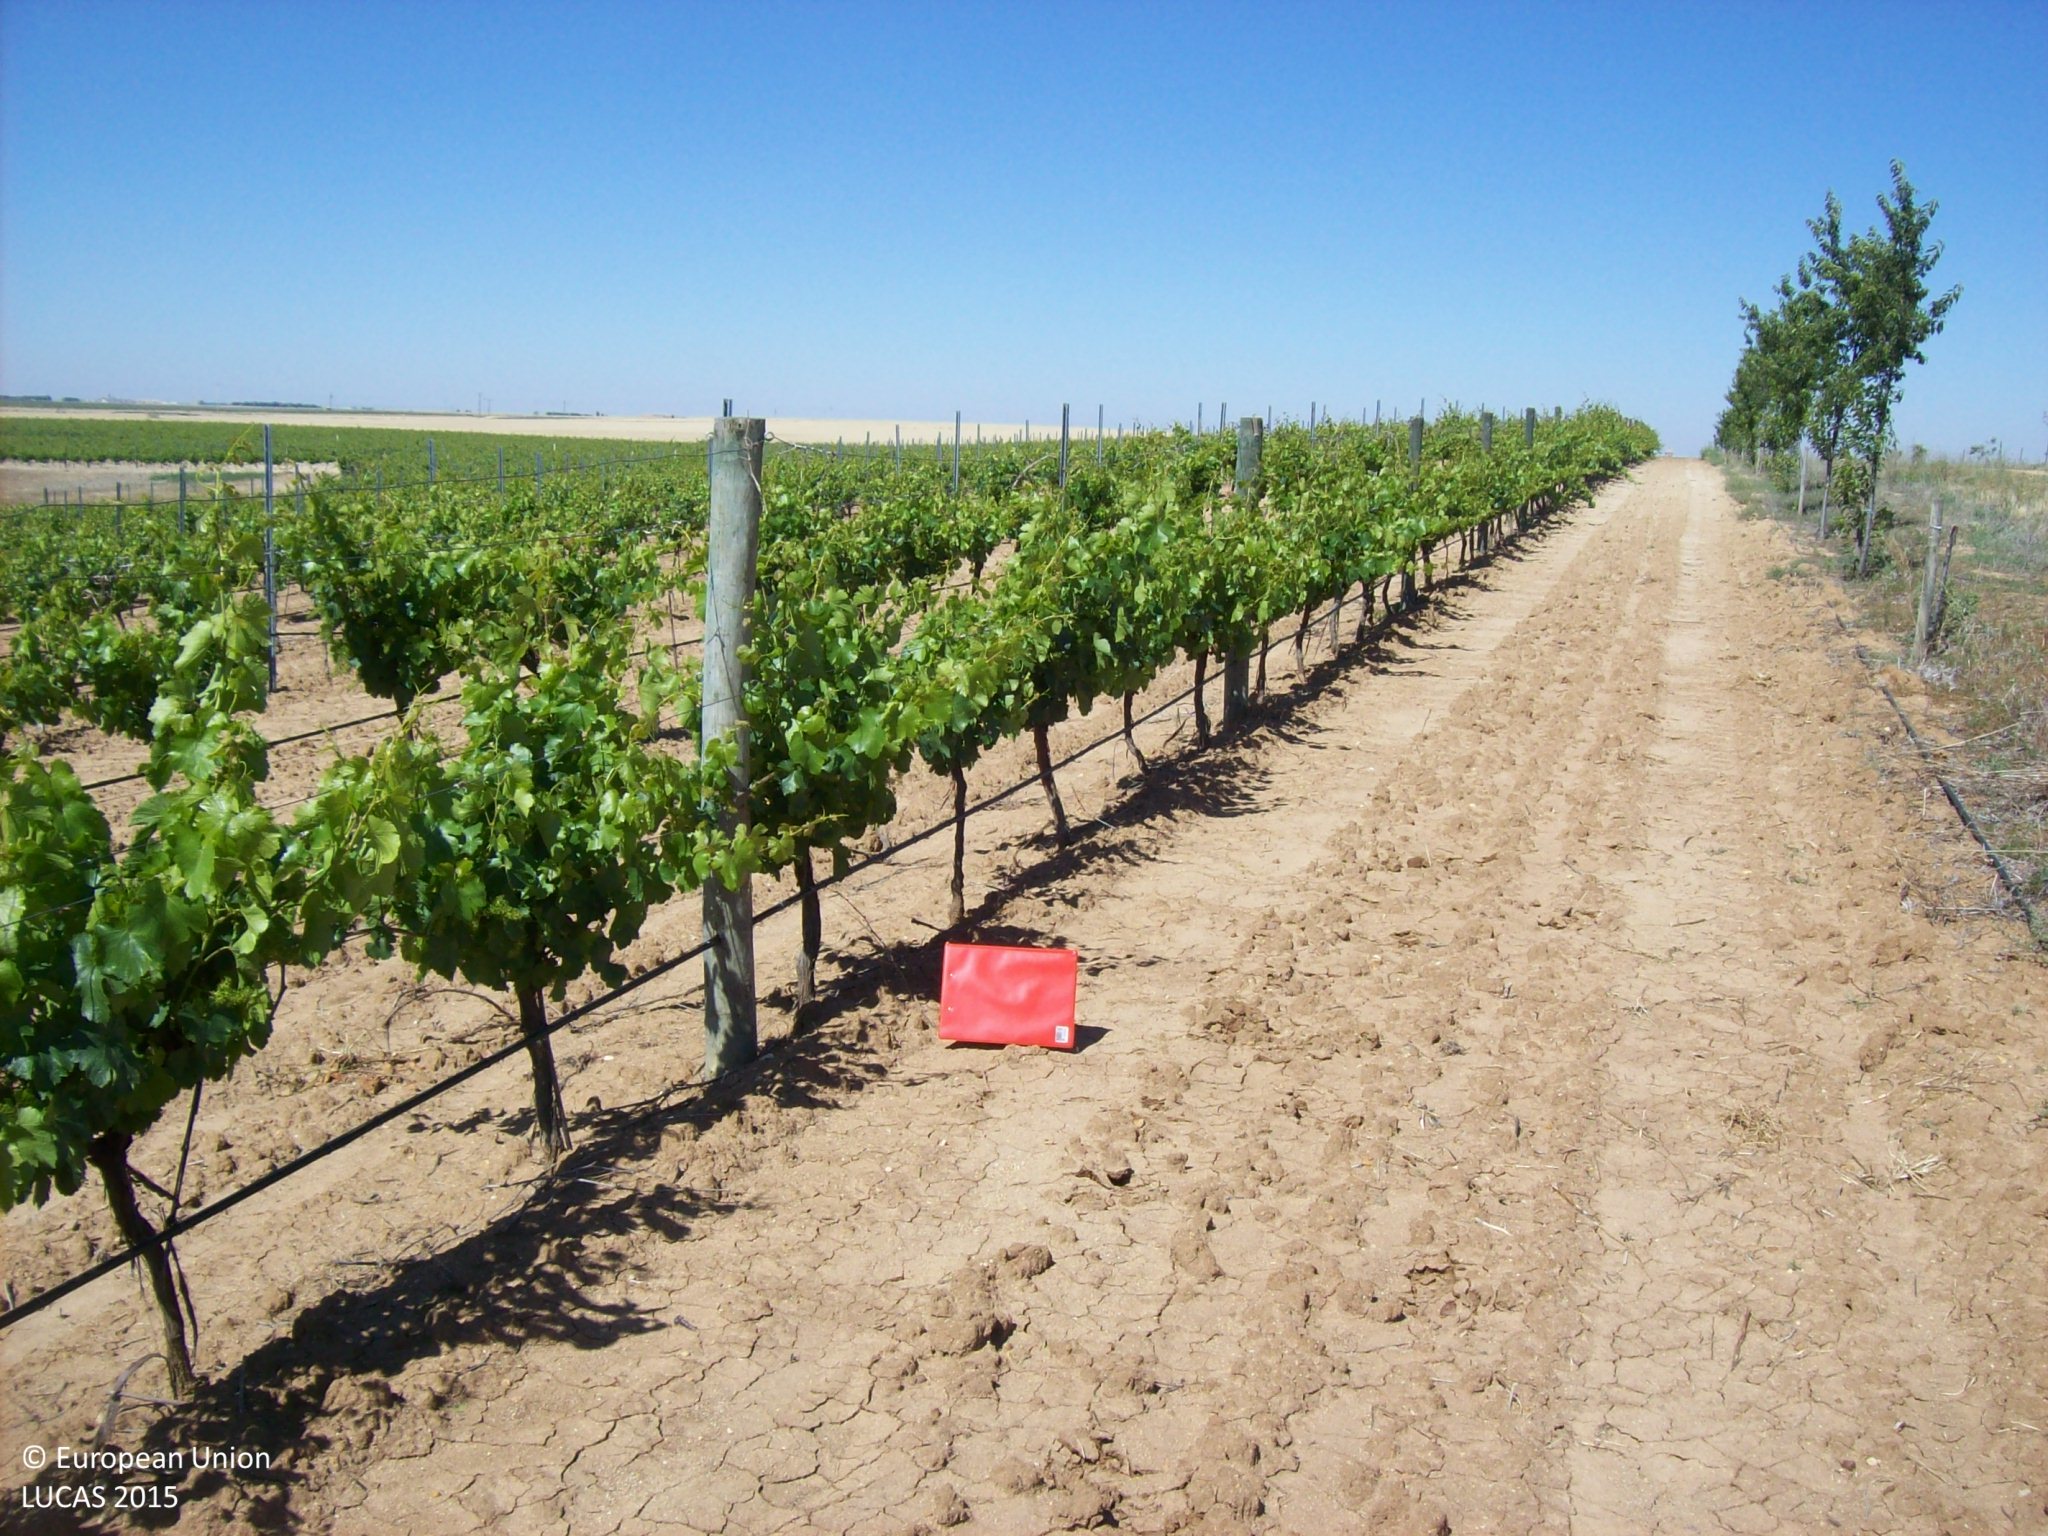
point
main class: Cropland
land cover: Vineyards
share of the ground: 25 - 50 %
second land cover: Other bare soil
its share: > 75 %
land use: Agriculture (excluding fallow land and kitchen gardens)
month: June
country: ES
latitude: 41.2688
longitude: -5.0267
